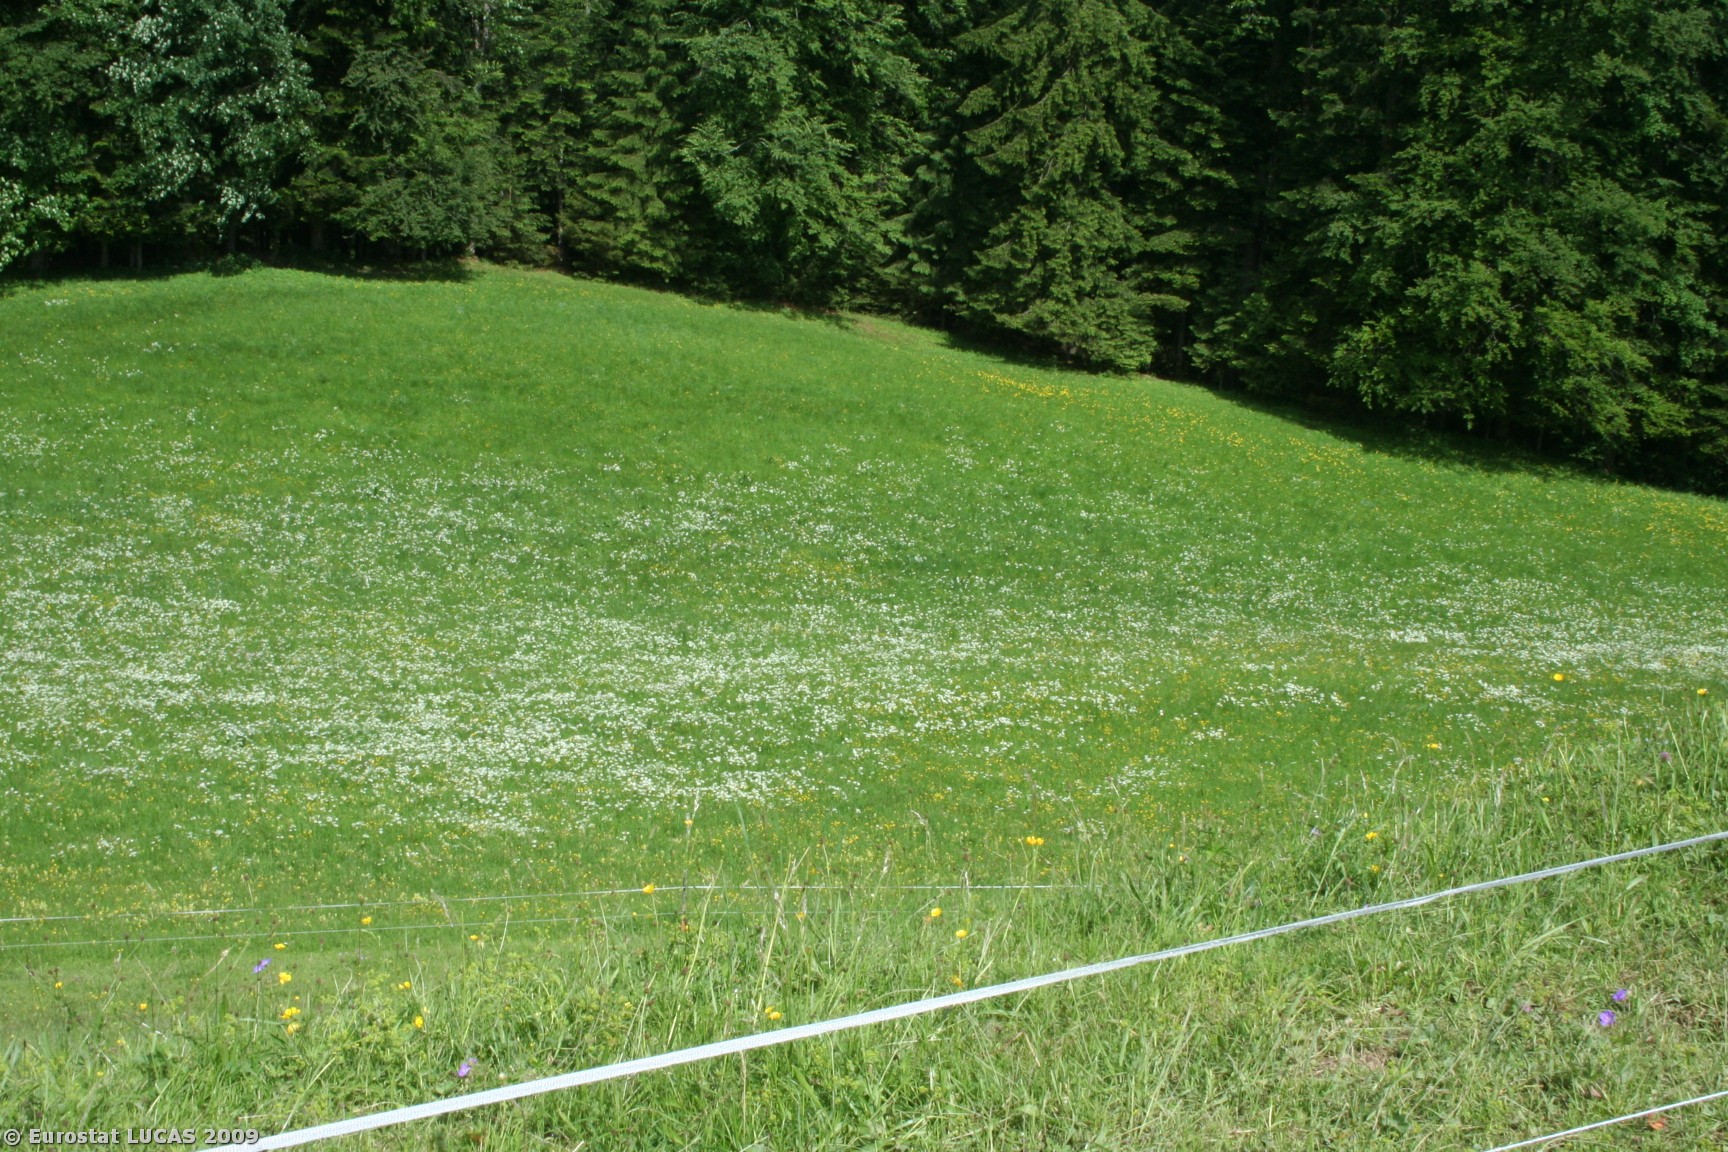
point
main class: Grassland
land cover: Grassland without tree/shrub cover
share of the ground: > 75 %
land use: Agriculture (excluding fallow land and kitchen gardens)
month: May
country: AT
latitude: 47.6366
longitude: 13.2061
